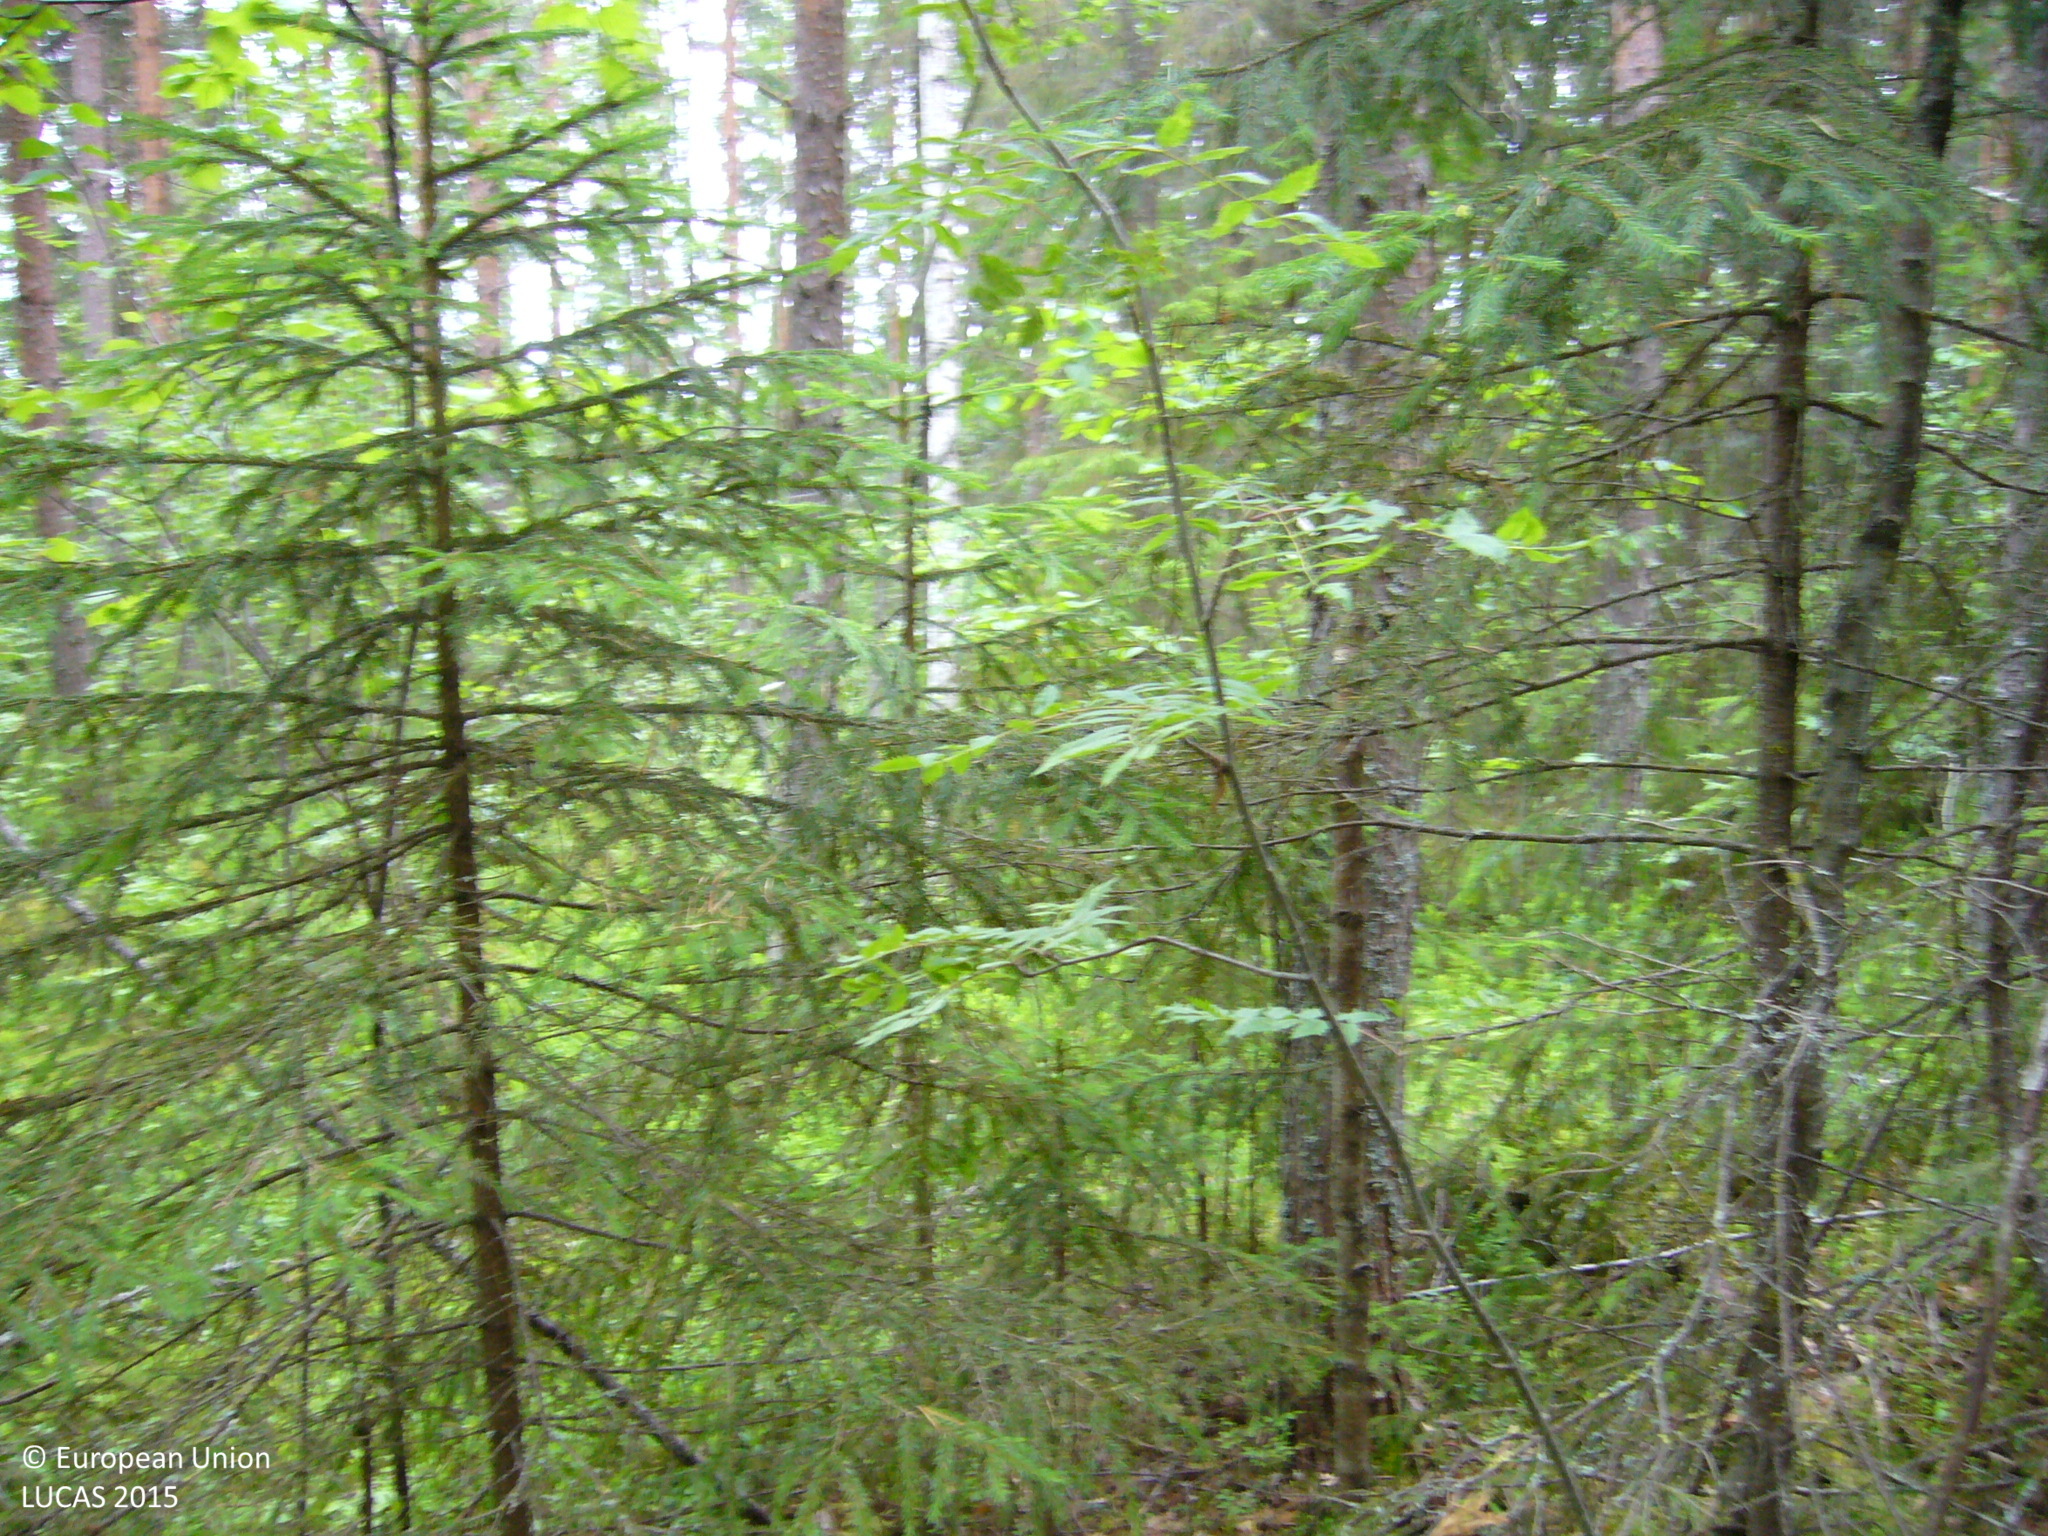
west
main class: Woodland
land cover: Spruce dominated mixed woodland
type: boreal forest
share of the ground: 50 - 75 %
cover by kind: coniferous forest trees 50 %, broadleaved forest trees 25 %, shrubs 25 %
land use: Forestry
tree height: > 5 m
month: July
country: FI
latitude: 63.2764
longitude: 25.8794
